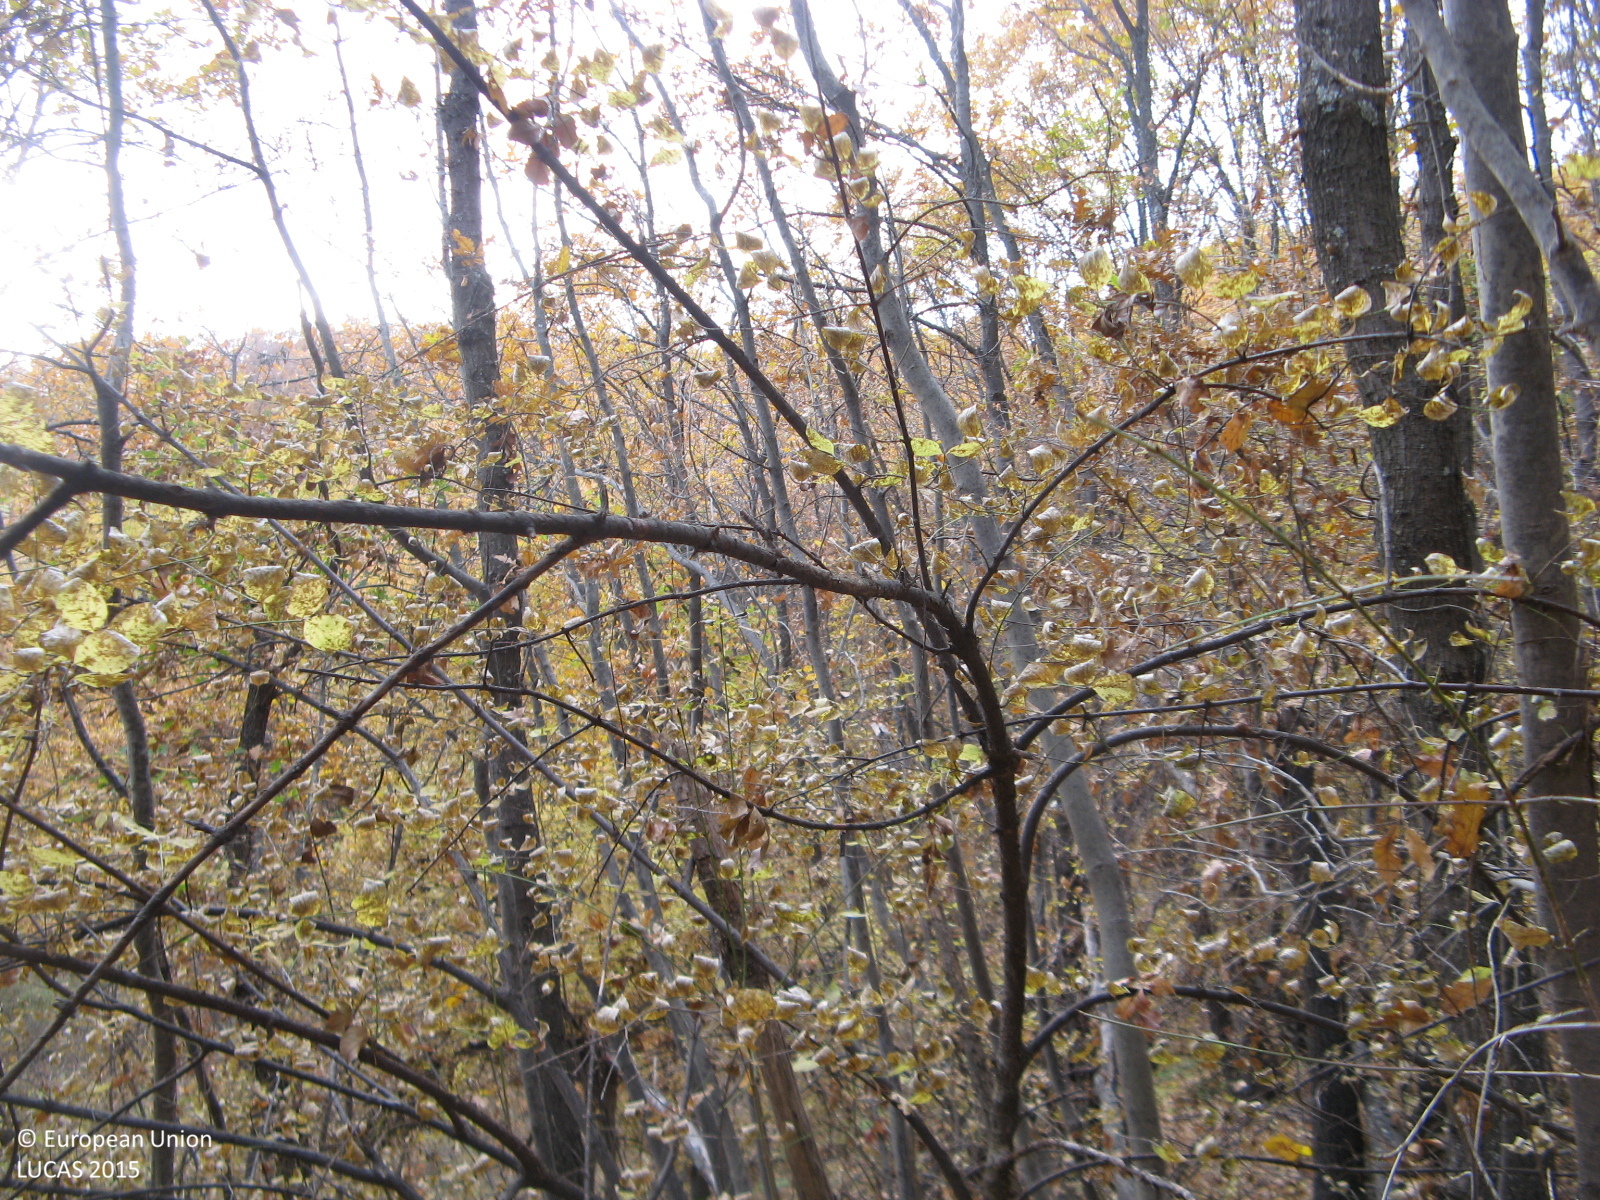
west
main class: Woodland
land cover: Broadleaved woodland
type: mesophytic deciduous forest
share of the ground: > 75 %
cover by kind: broadleaved forest trees 95 %, unconsolidated bare surface 5 %
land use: Forestry
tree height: > 5 m
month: November
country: BG
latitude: 41.7258
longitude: 25.9745
